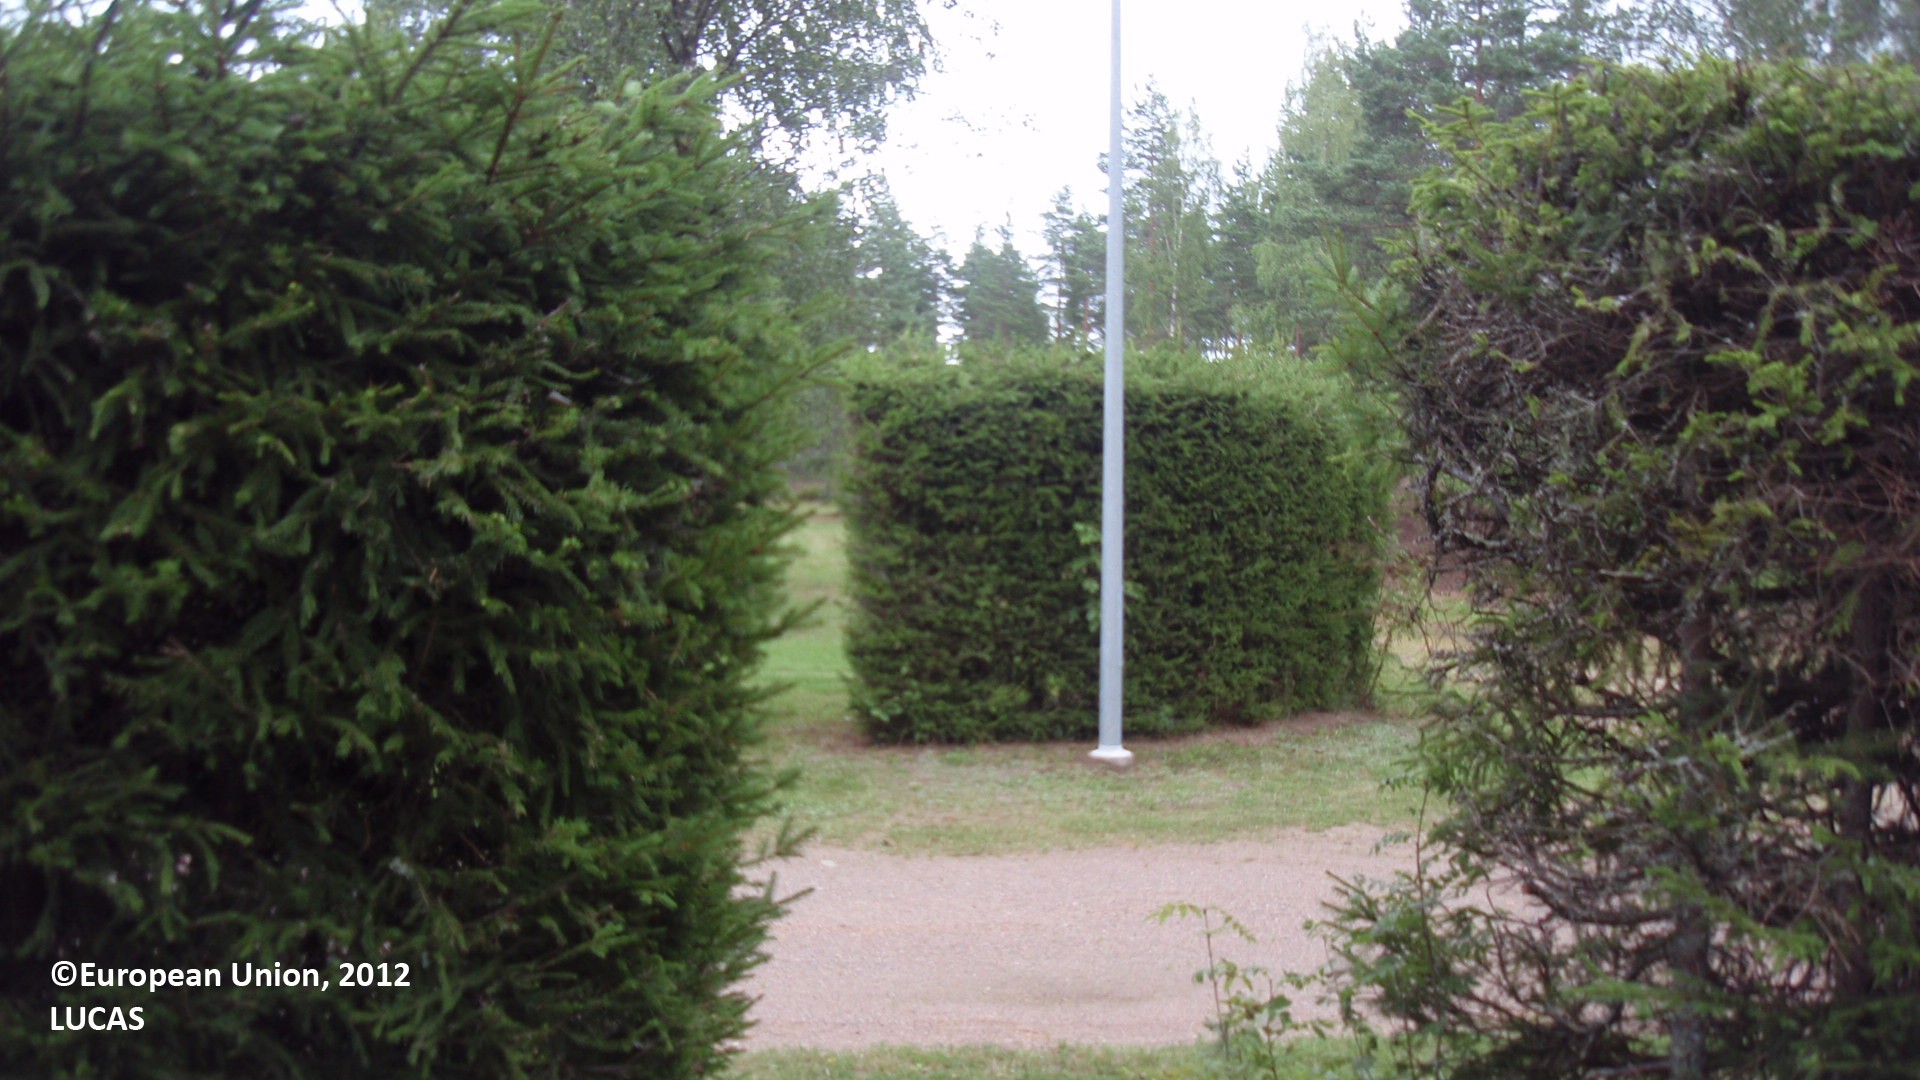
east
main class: Woodland
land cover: Pine dominated mixed woodland
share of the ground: 25 - 50 %
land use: Community services
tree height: > 5 m
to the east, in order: Pine dominated mixed woodland; Artificial constructions in urban areas
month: August
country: FI
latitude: 60.9199
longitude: 27.5405
